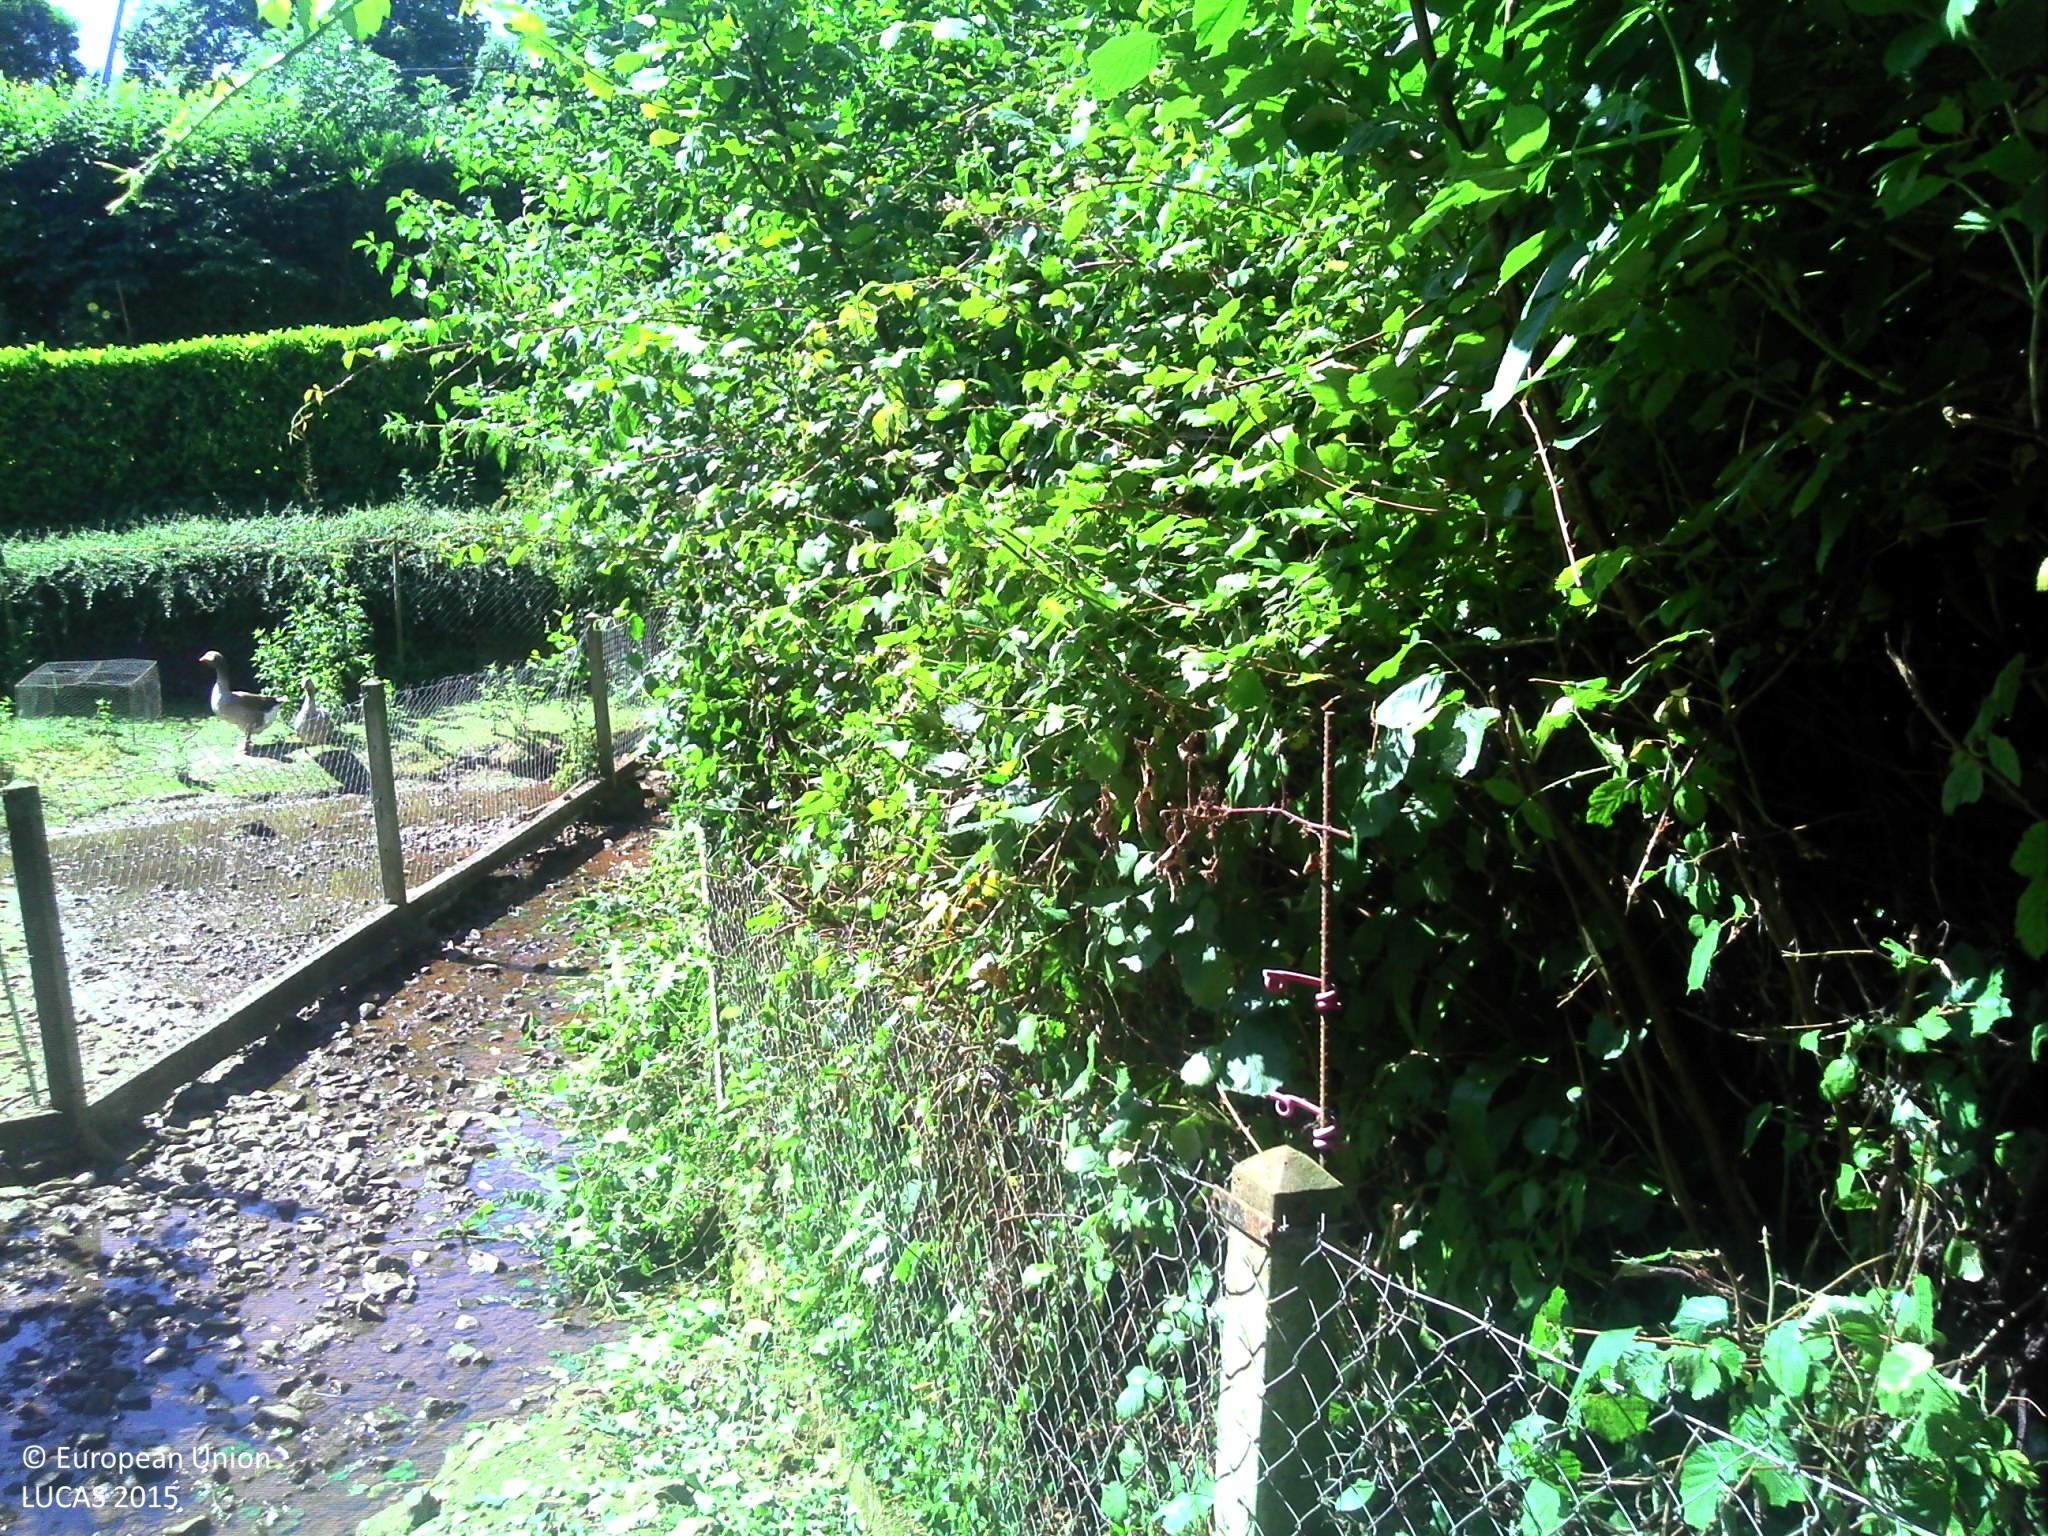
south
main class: Woodland
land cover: Broadleaved woodland
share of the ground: > 75 %
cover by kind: broadleaved forest trees 90 %, shrubs 10 %
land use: Forestry
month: July
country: FR
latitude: 49.0100
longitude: -1.4083
